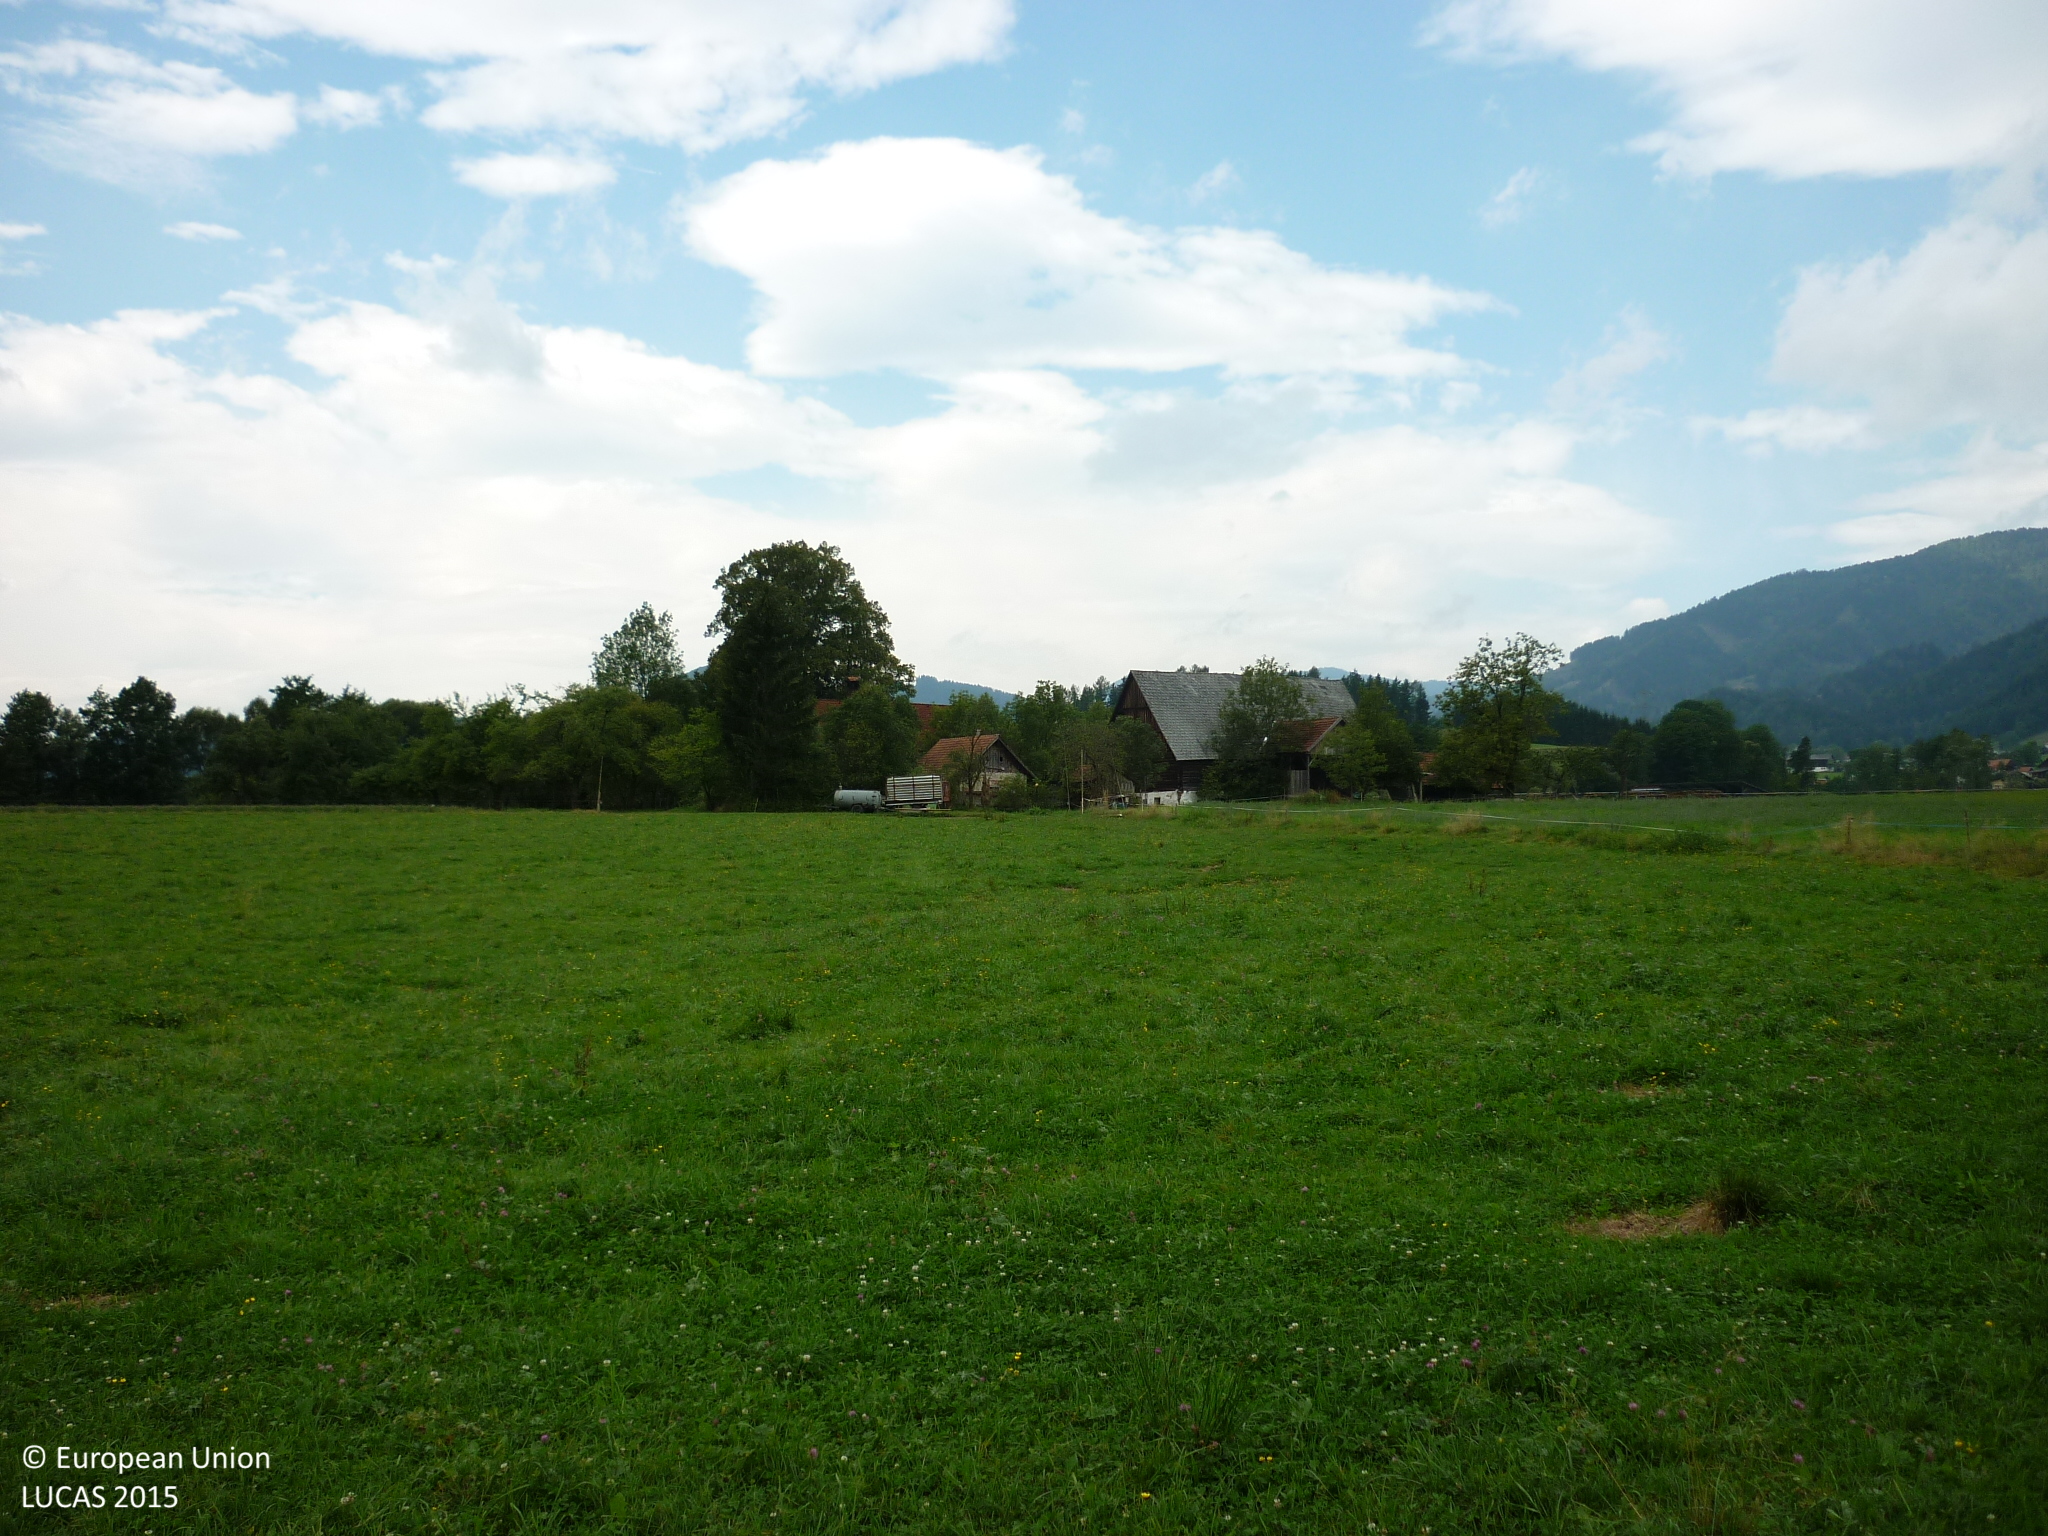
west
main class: Grassland
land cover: Grassland without tree/shrub cover
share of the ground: > 75 %
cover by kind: herbaceous plants 100 %
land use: Agriculture (excluding fallow land and kitchen gardens)
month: August
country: AT
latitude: 47.4805
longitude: 15.3485
